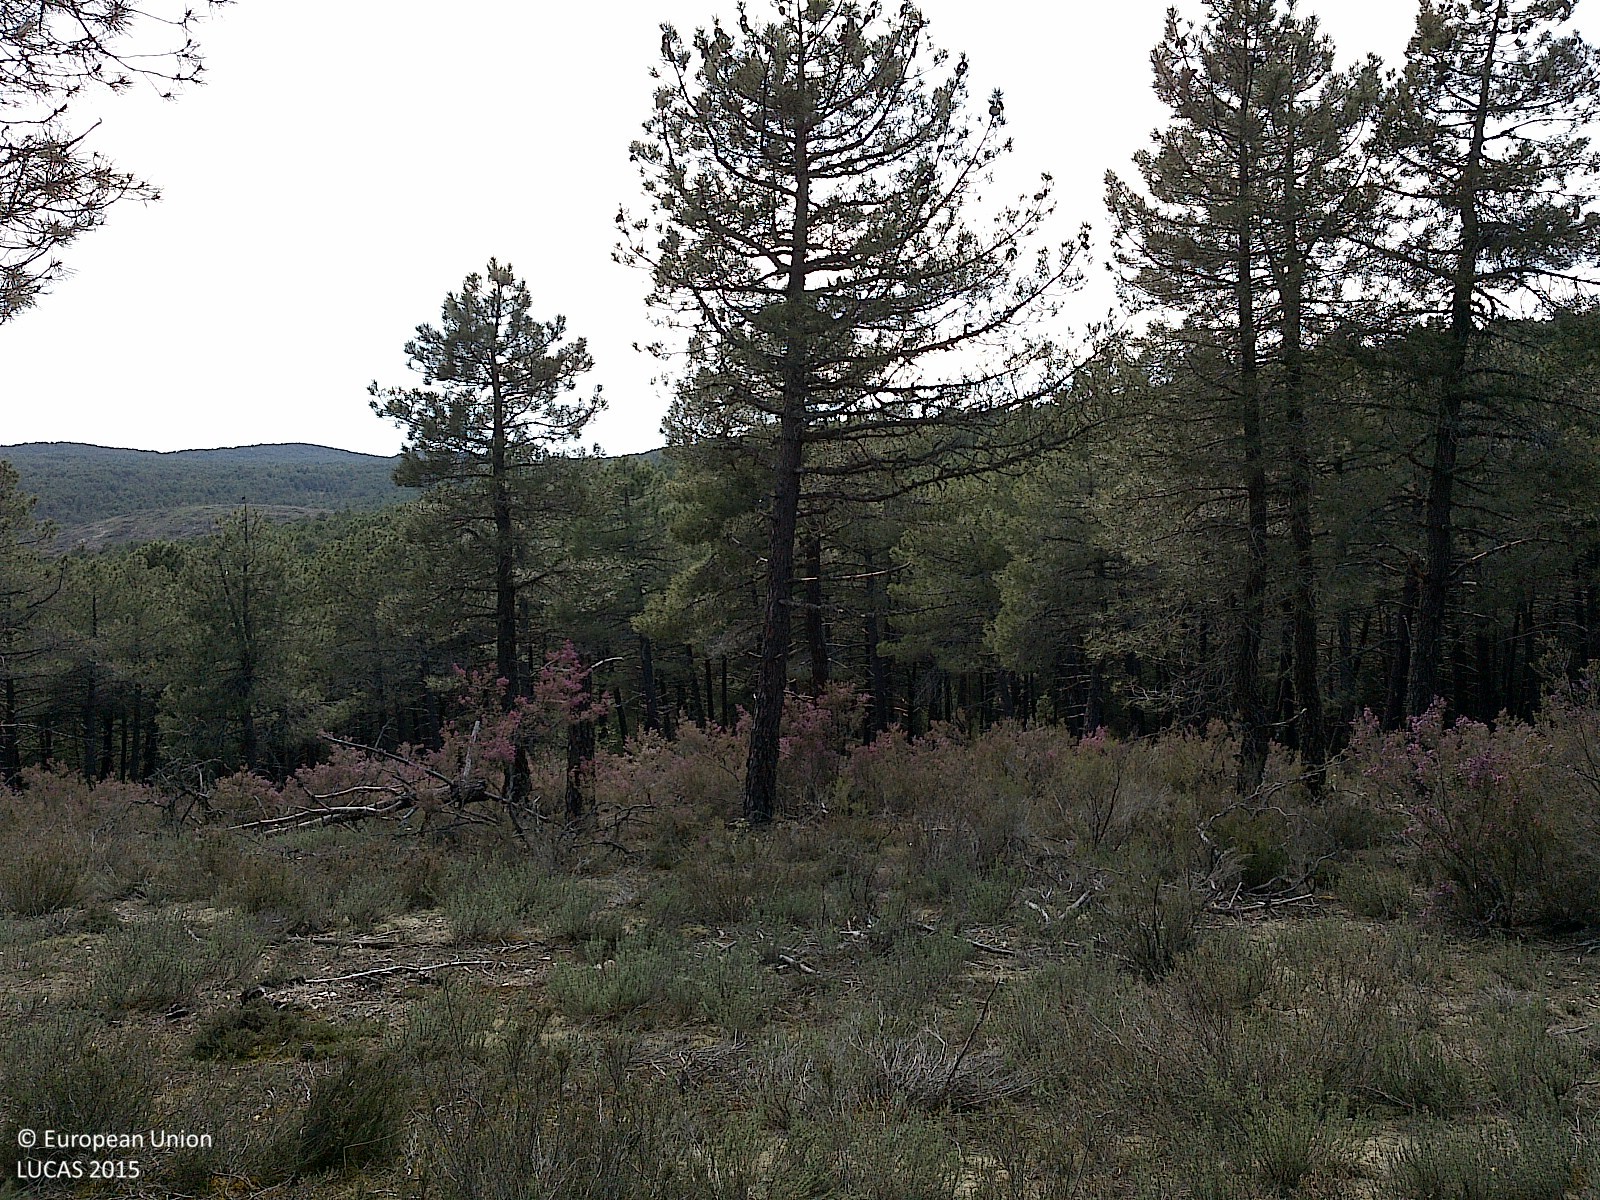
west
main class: Woodland
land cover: Pine dominated coniferous woodland
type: coniferous forest of the mediterranean region
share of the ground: 50 - 75 %
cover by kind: coniferous forest trees 55 %, shrubs 25 %, herbaceous plants 20 %
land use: Forestry
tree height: > 5 m
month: April
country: ES
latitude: 41.8686
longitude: -3.2658
